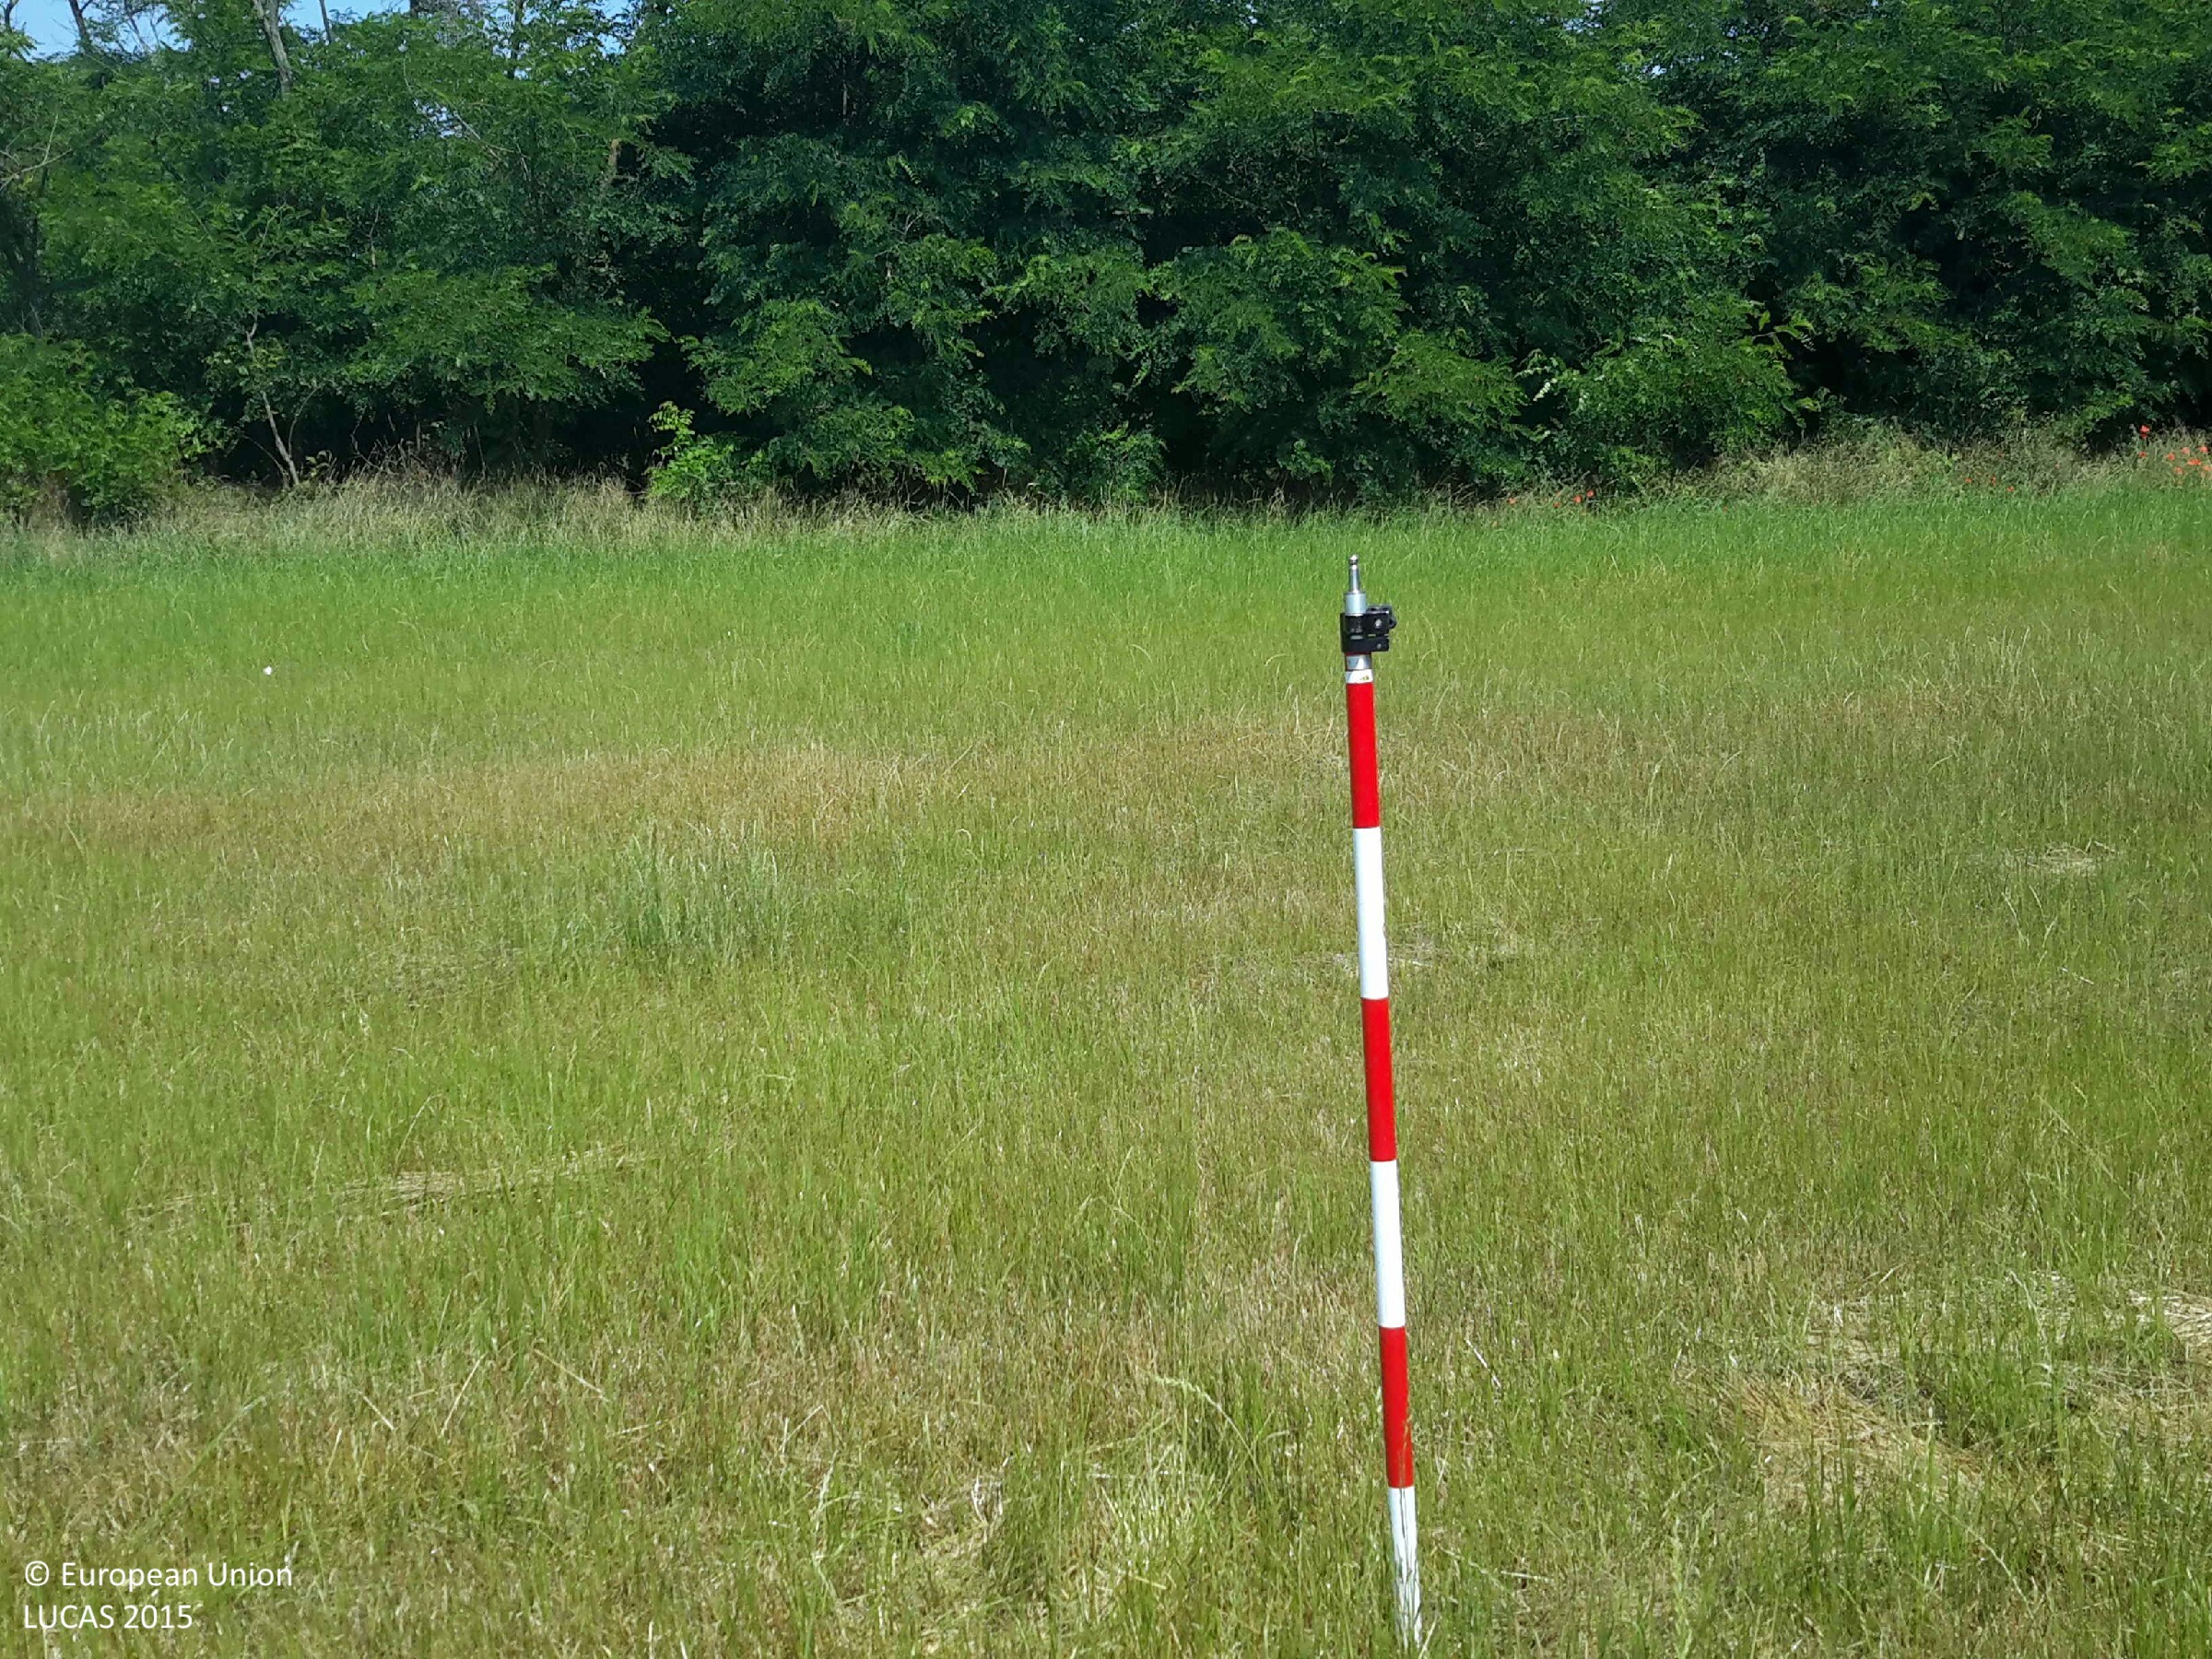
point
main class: Grassland
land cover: Grassland without tree/shrub cover
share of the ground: > 75 %
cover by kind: herbaceous plants 100 %
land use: Agriculture (excluding fallow land and kitchen gardens)
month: July
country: HU
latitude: 47.3113
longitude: 17.3217
